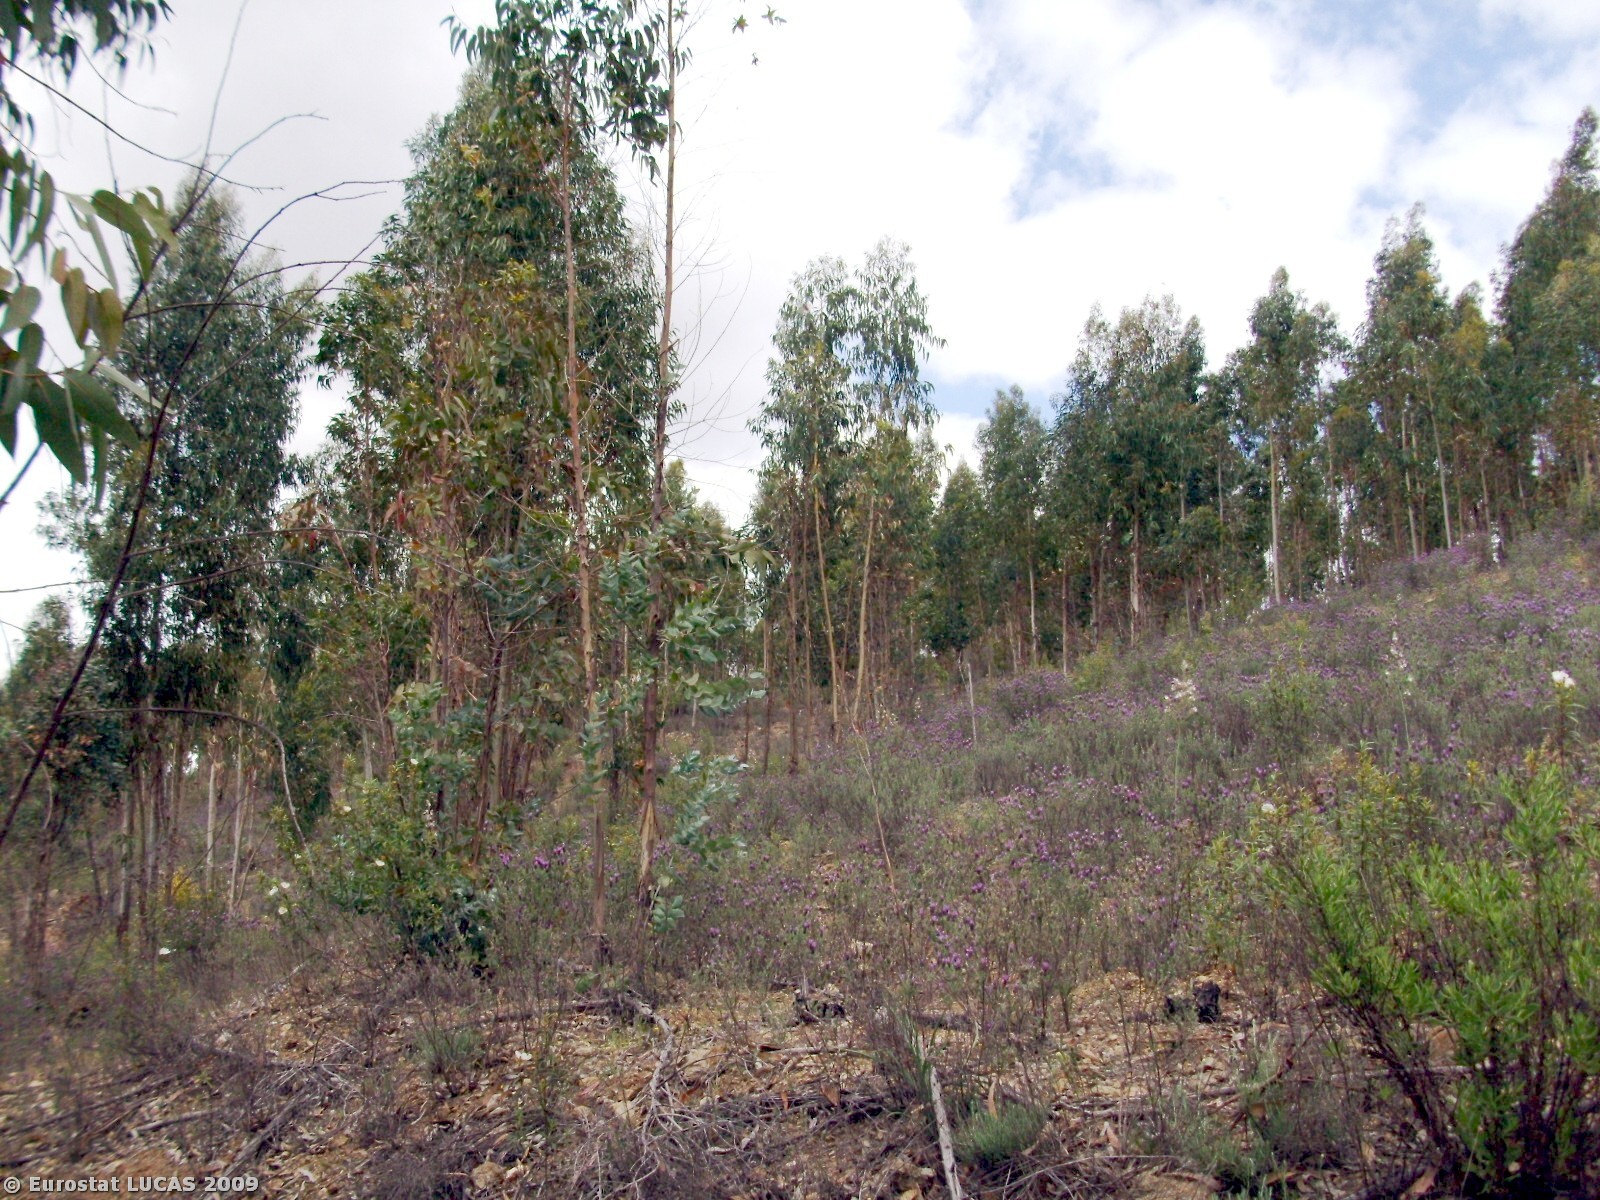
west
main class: Woodland
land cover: Broadleaved woodland
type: plantations and self-sown exotic forest
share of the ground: 50 - 75 %
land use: Forestry
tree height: > 5 m
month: April
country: PT
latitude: 39.6511
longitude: -7.5435
